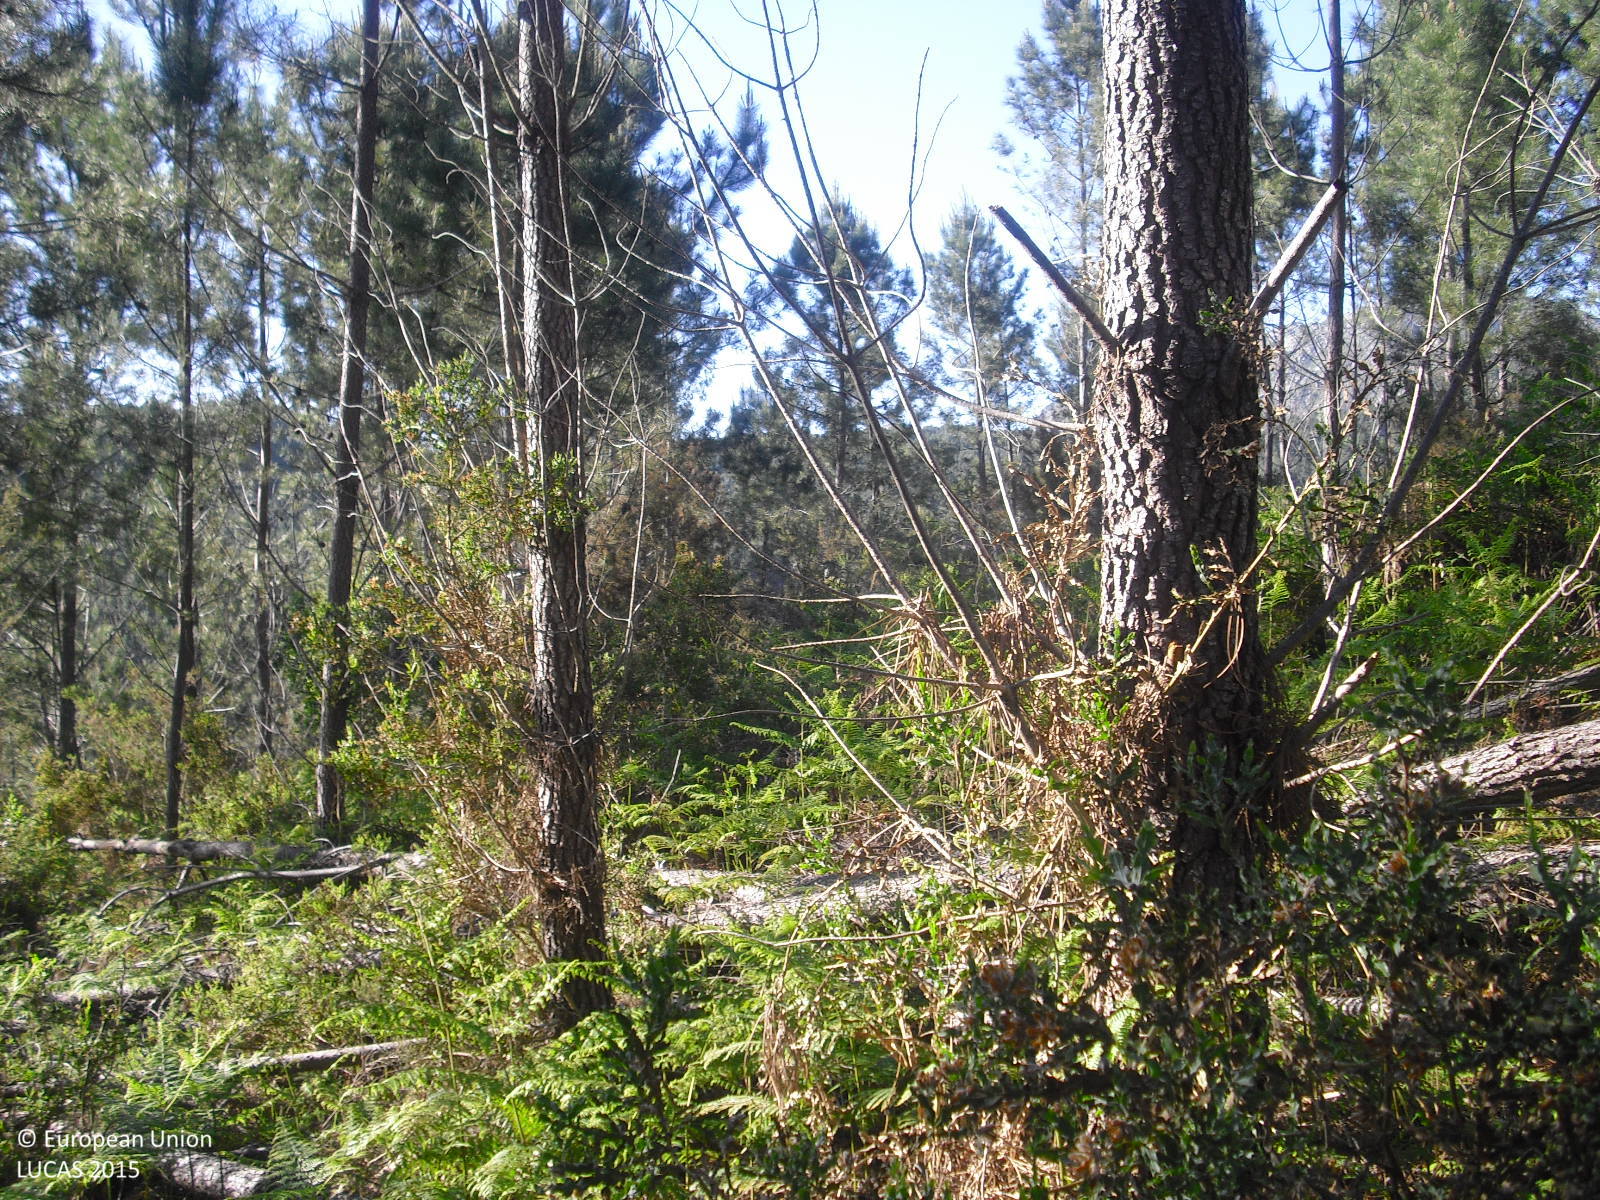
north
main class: Woodland
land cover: Pine dominated coniferous woodland
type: hemiboreal forest and nemoral coniferous forest and mixed broadleaved-coniferous forest
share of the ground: 25 - 50 %
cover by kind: coniferous forest trees 50 %, shrubs 50 %
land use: Forestry
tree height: > 5 m
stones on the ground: 25 - 50 %
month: May
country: ES
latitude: 41.8942
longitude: -8.1958
